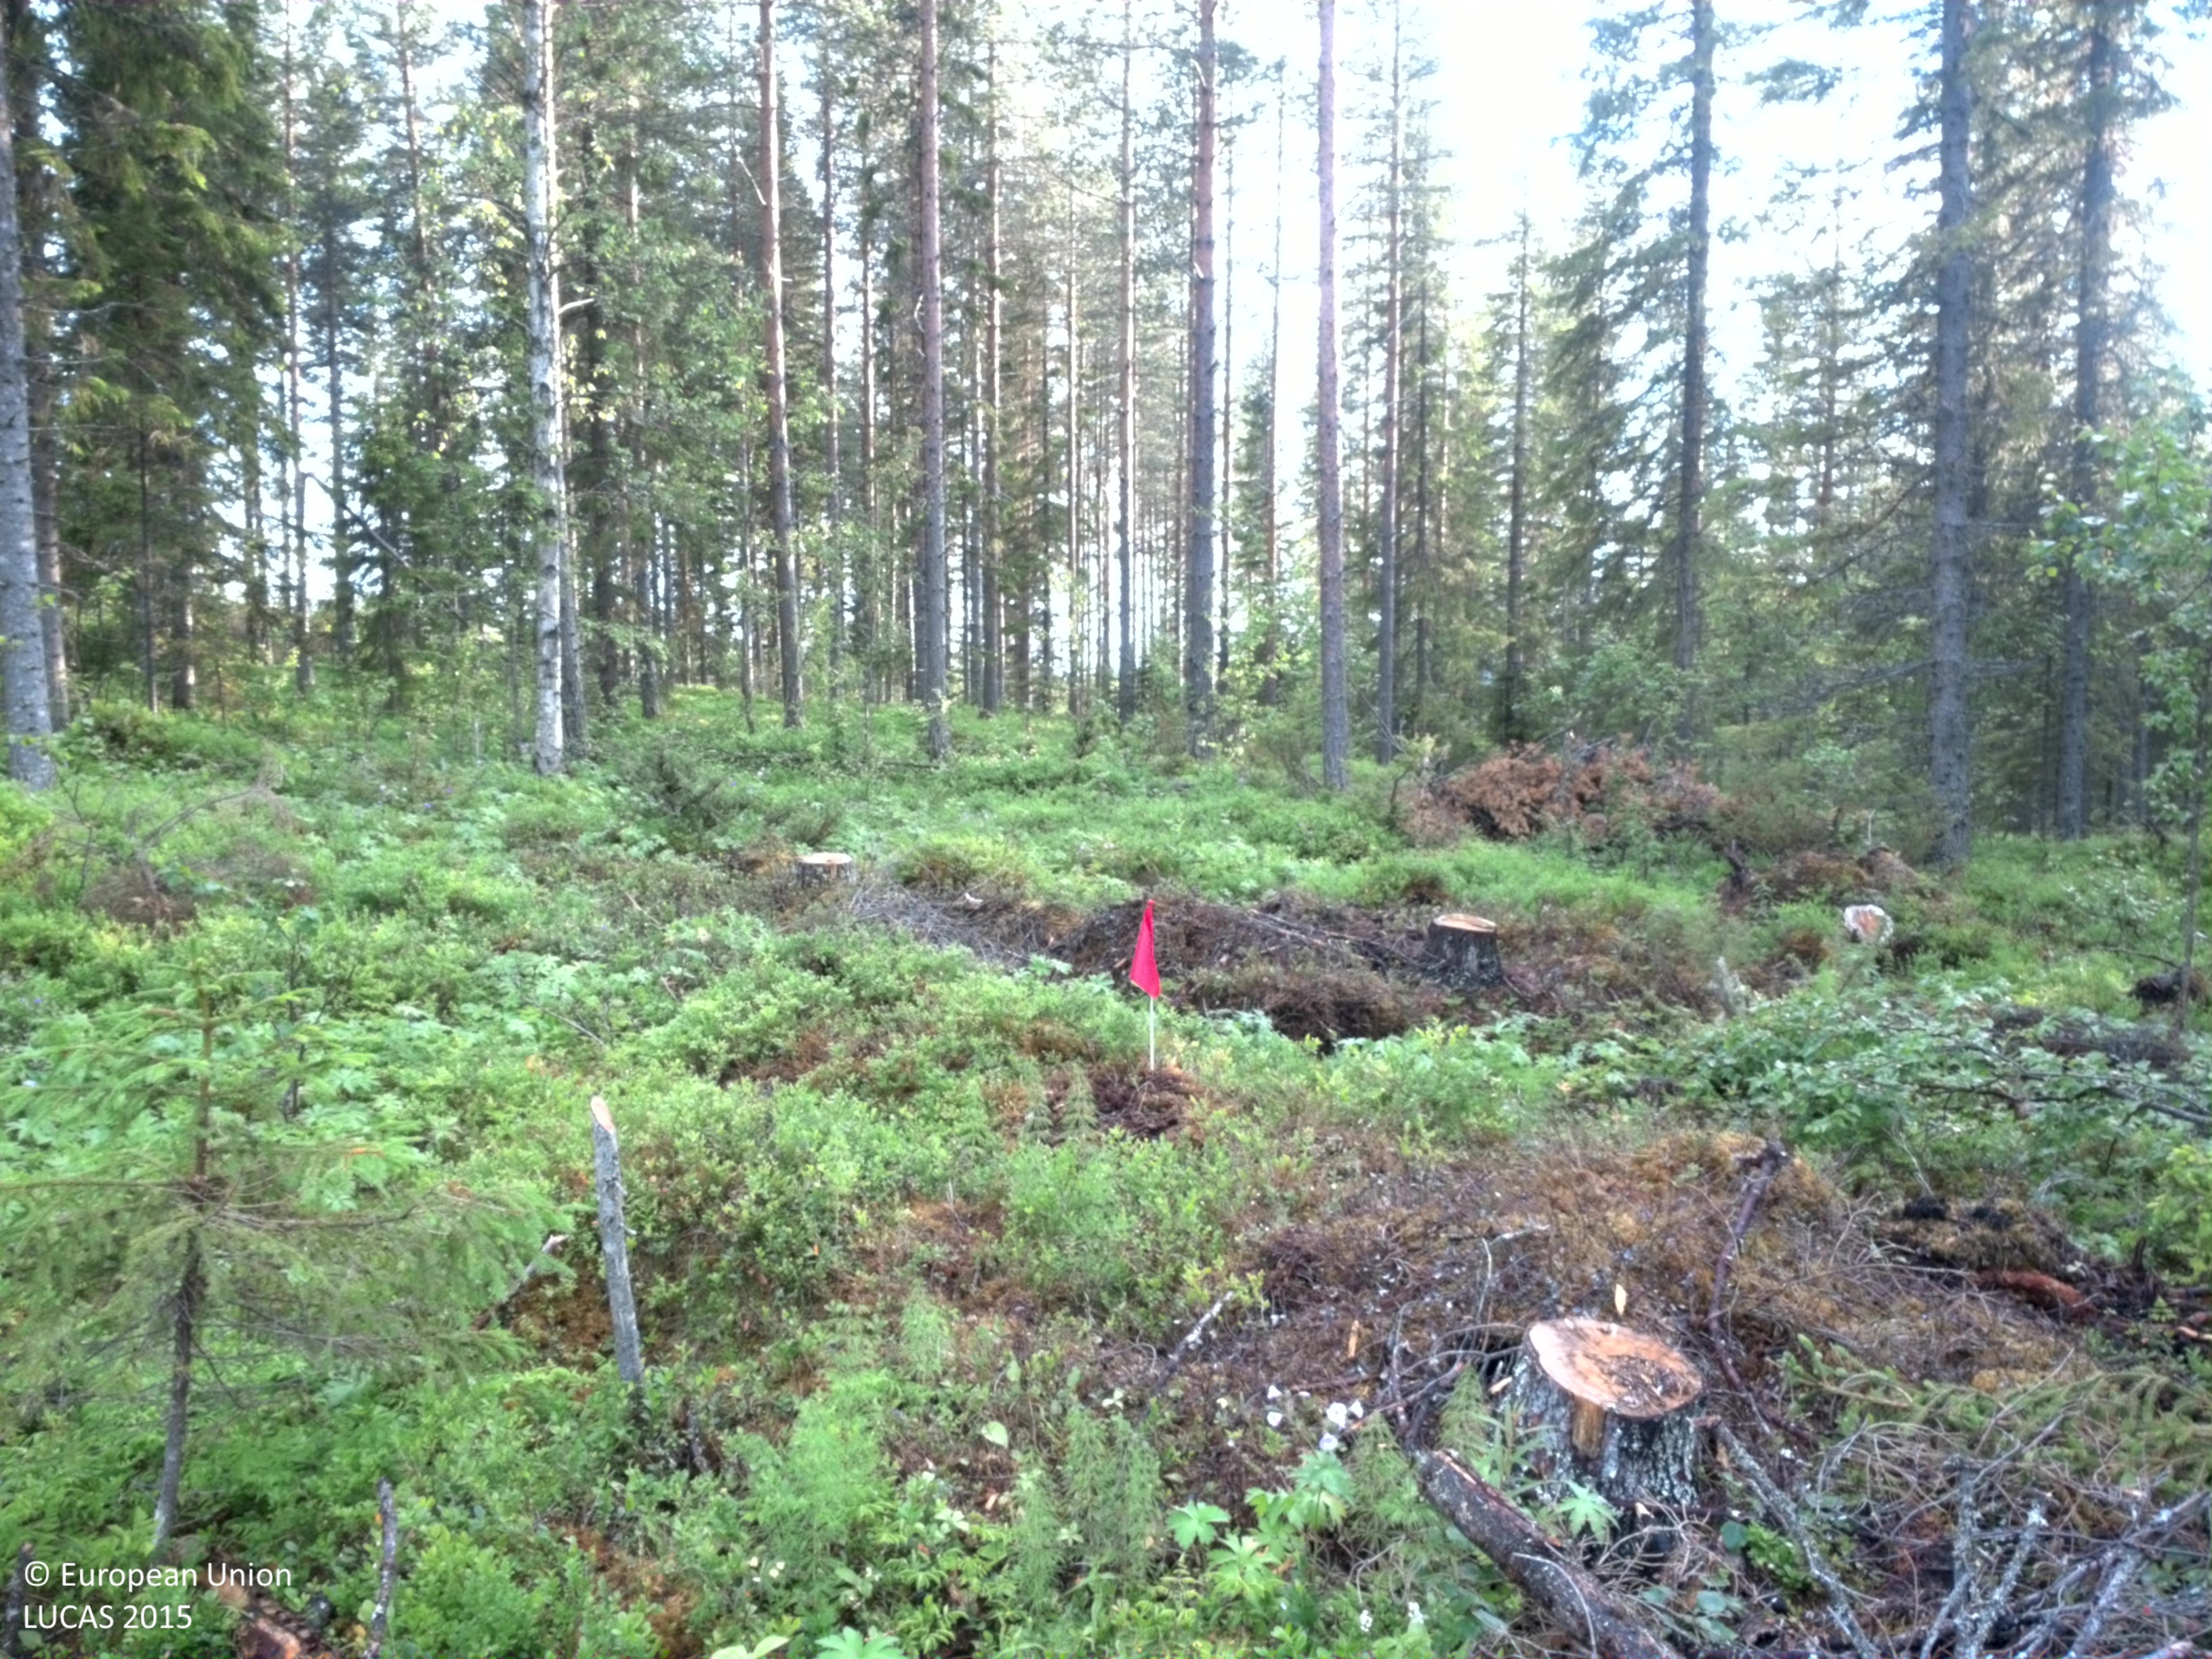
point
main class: Woodland
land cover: Pine dominated coniferous woodland
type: boreal forest
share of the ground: 25 - 50 %
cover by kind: coniferous forest trees 40 %, shrubs 40 %, broadleaved forest trees 10 %, herbaceous plants 10 %
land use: Forestry
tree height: > 5 m
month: July
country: SE
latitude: 64.6458
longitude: 18.4437
